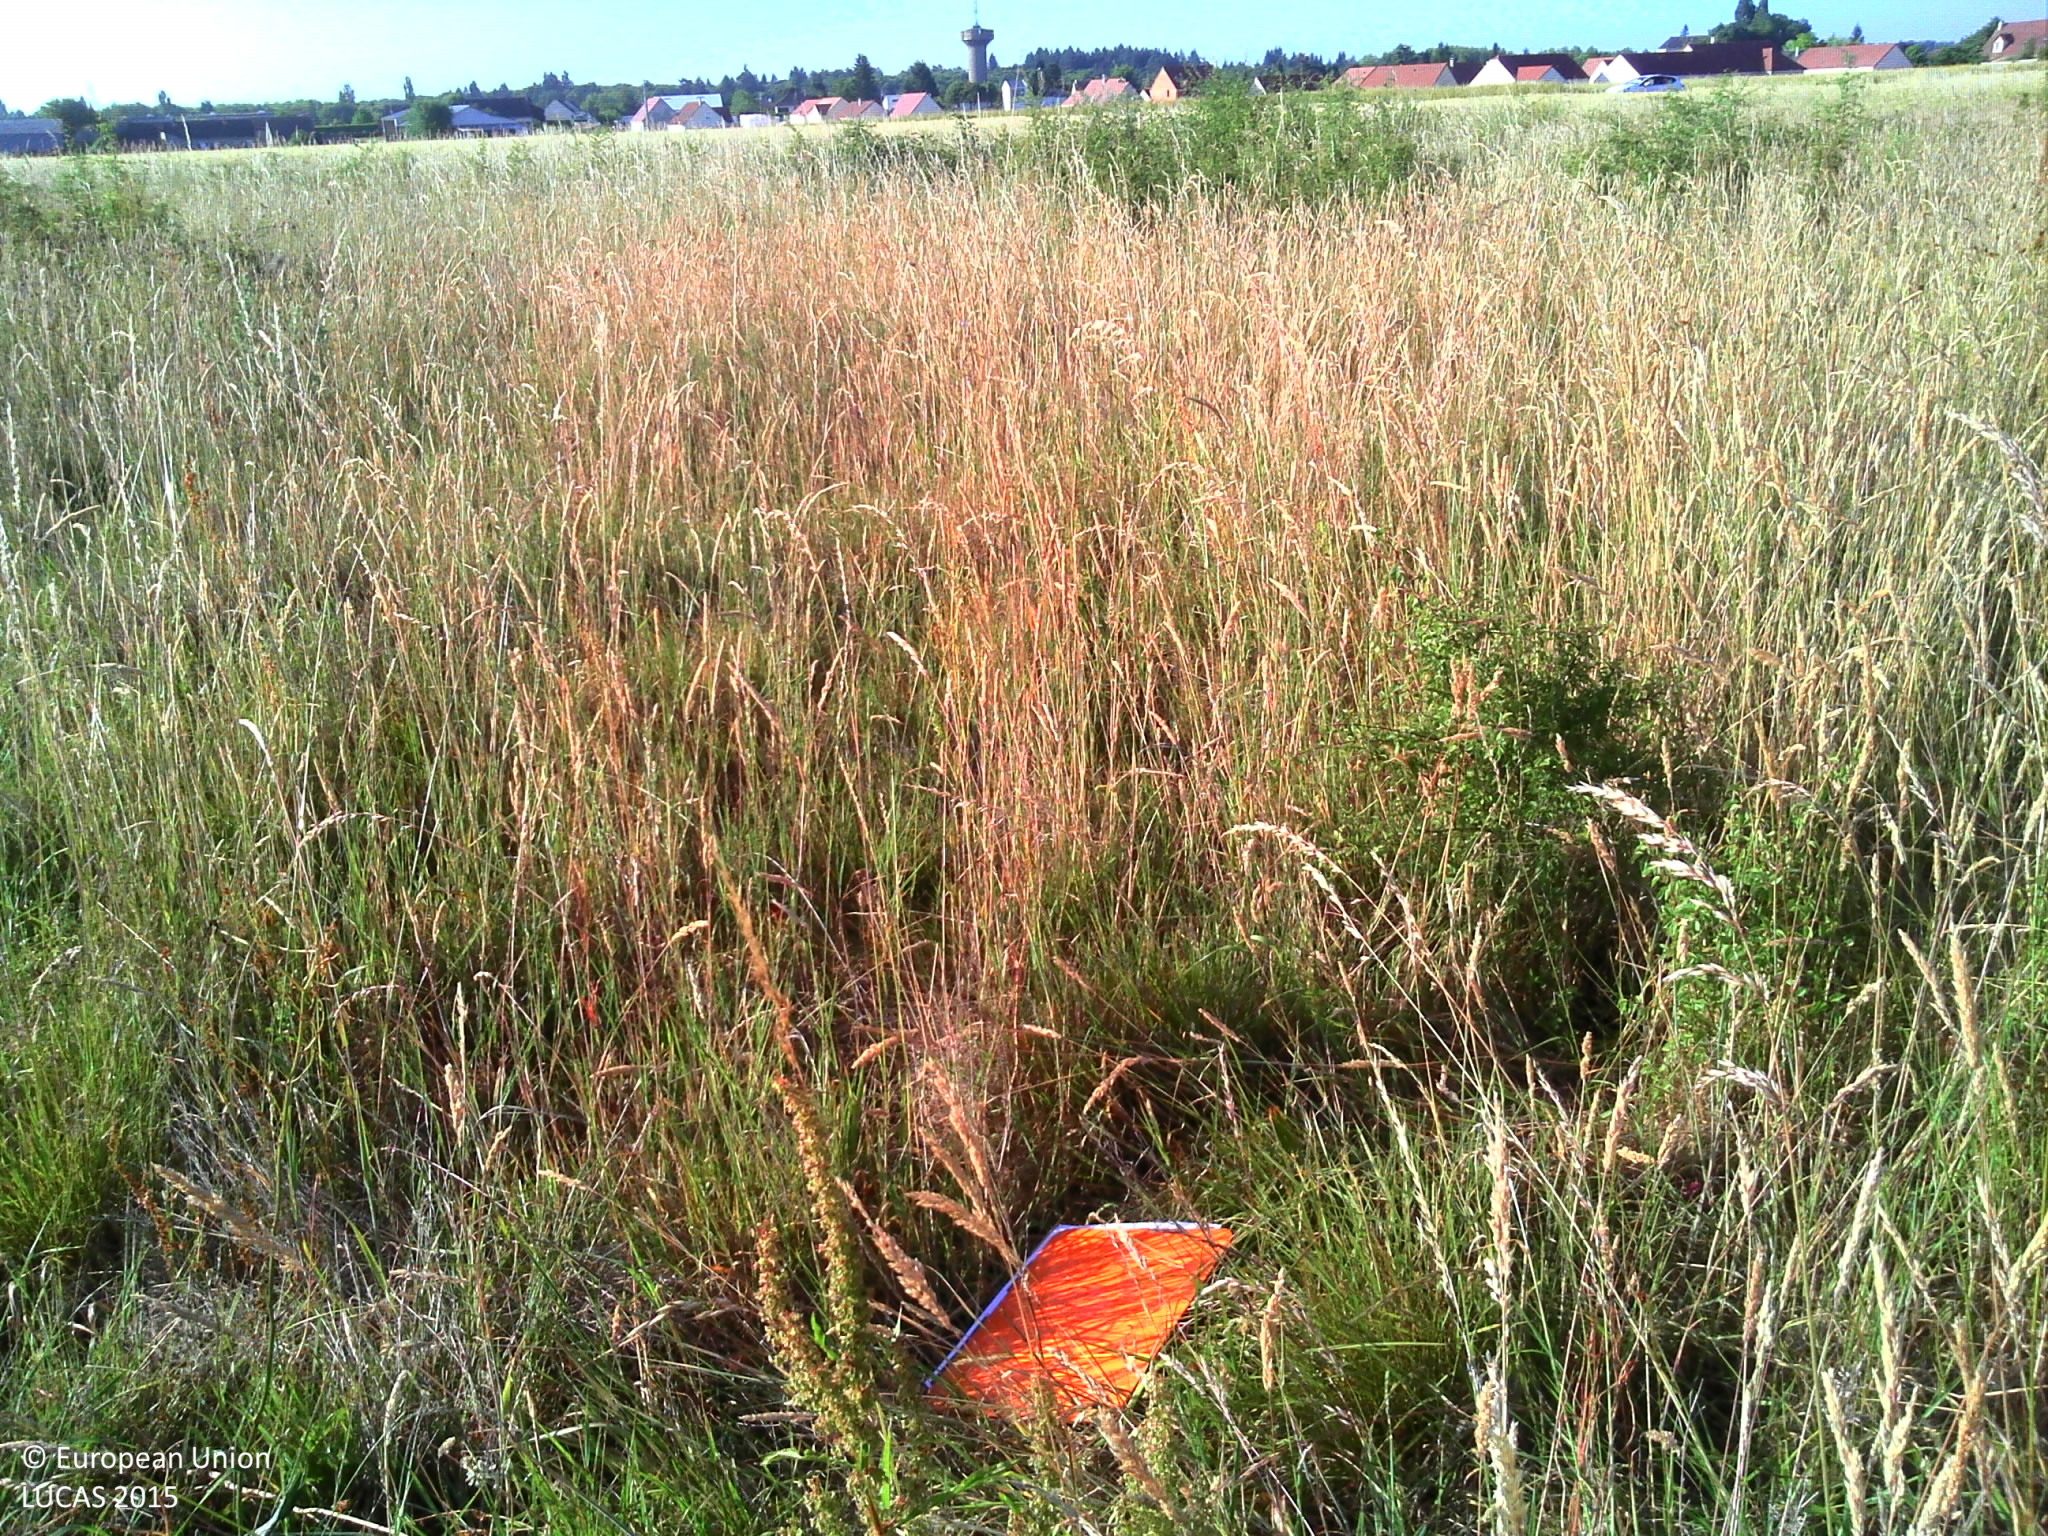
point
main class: Grassland
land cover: Grassland without tree/shrub cover
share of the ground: > 75 %
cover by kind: herbaceous plants 100 %
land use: Agriculture (excluding fallow land and kitchen gardens)
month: June
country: FR
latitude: 47.7714
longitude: 2.0222
